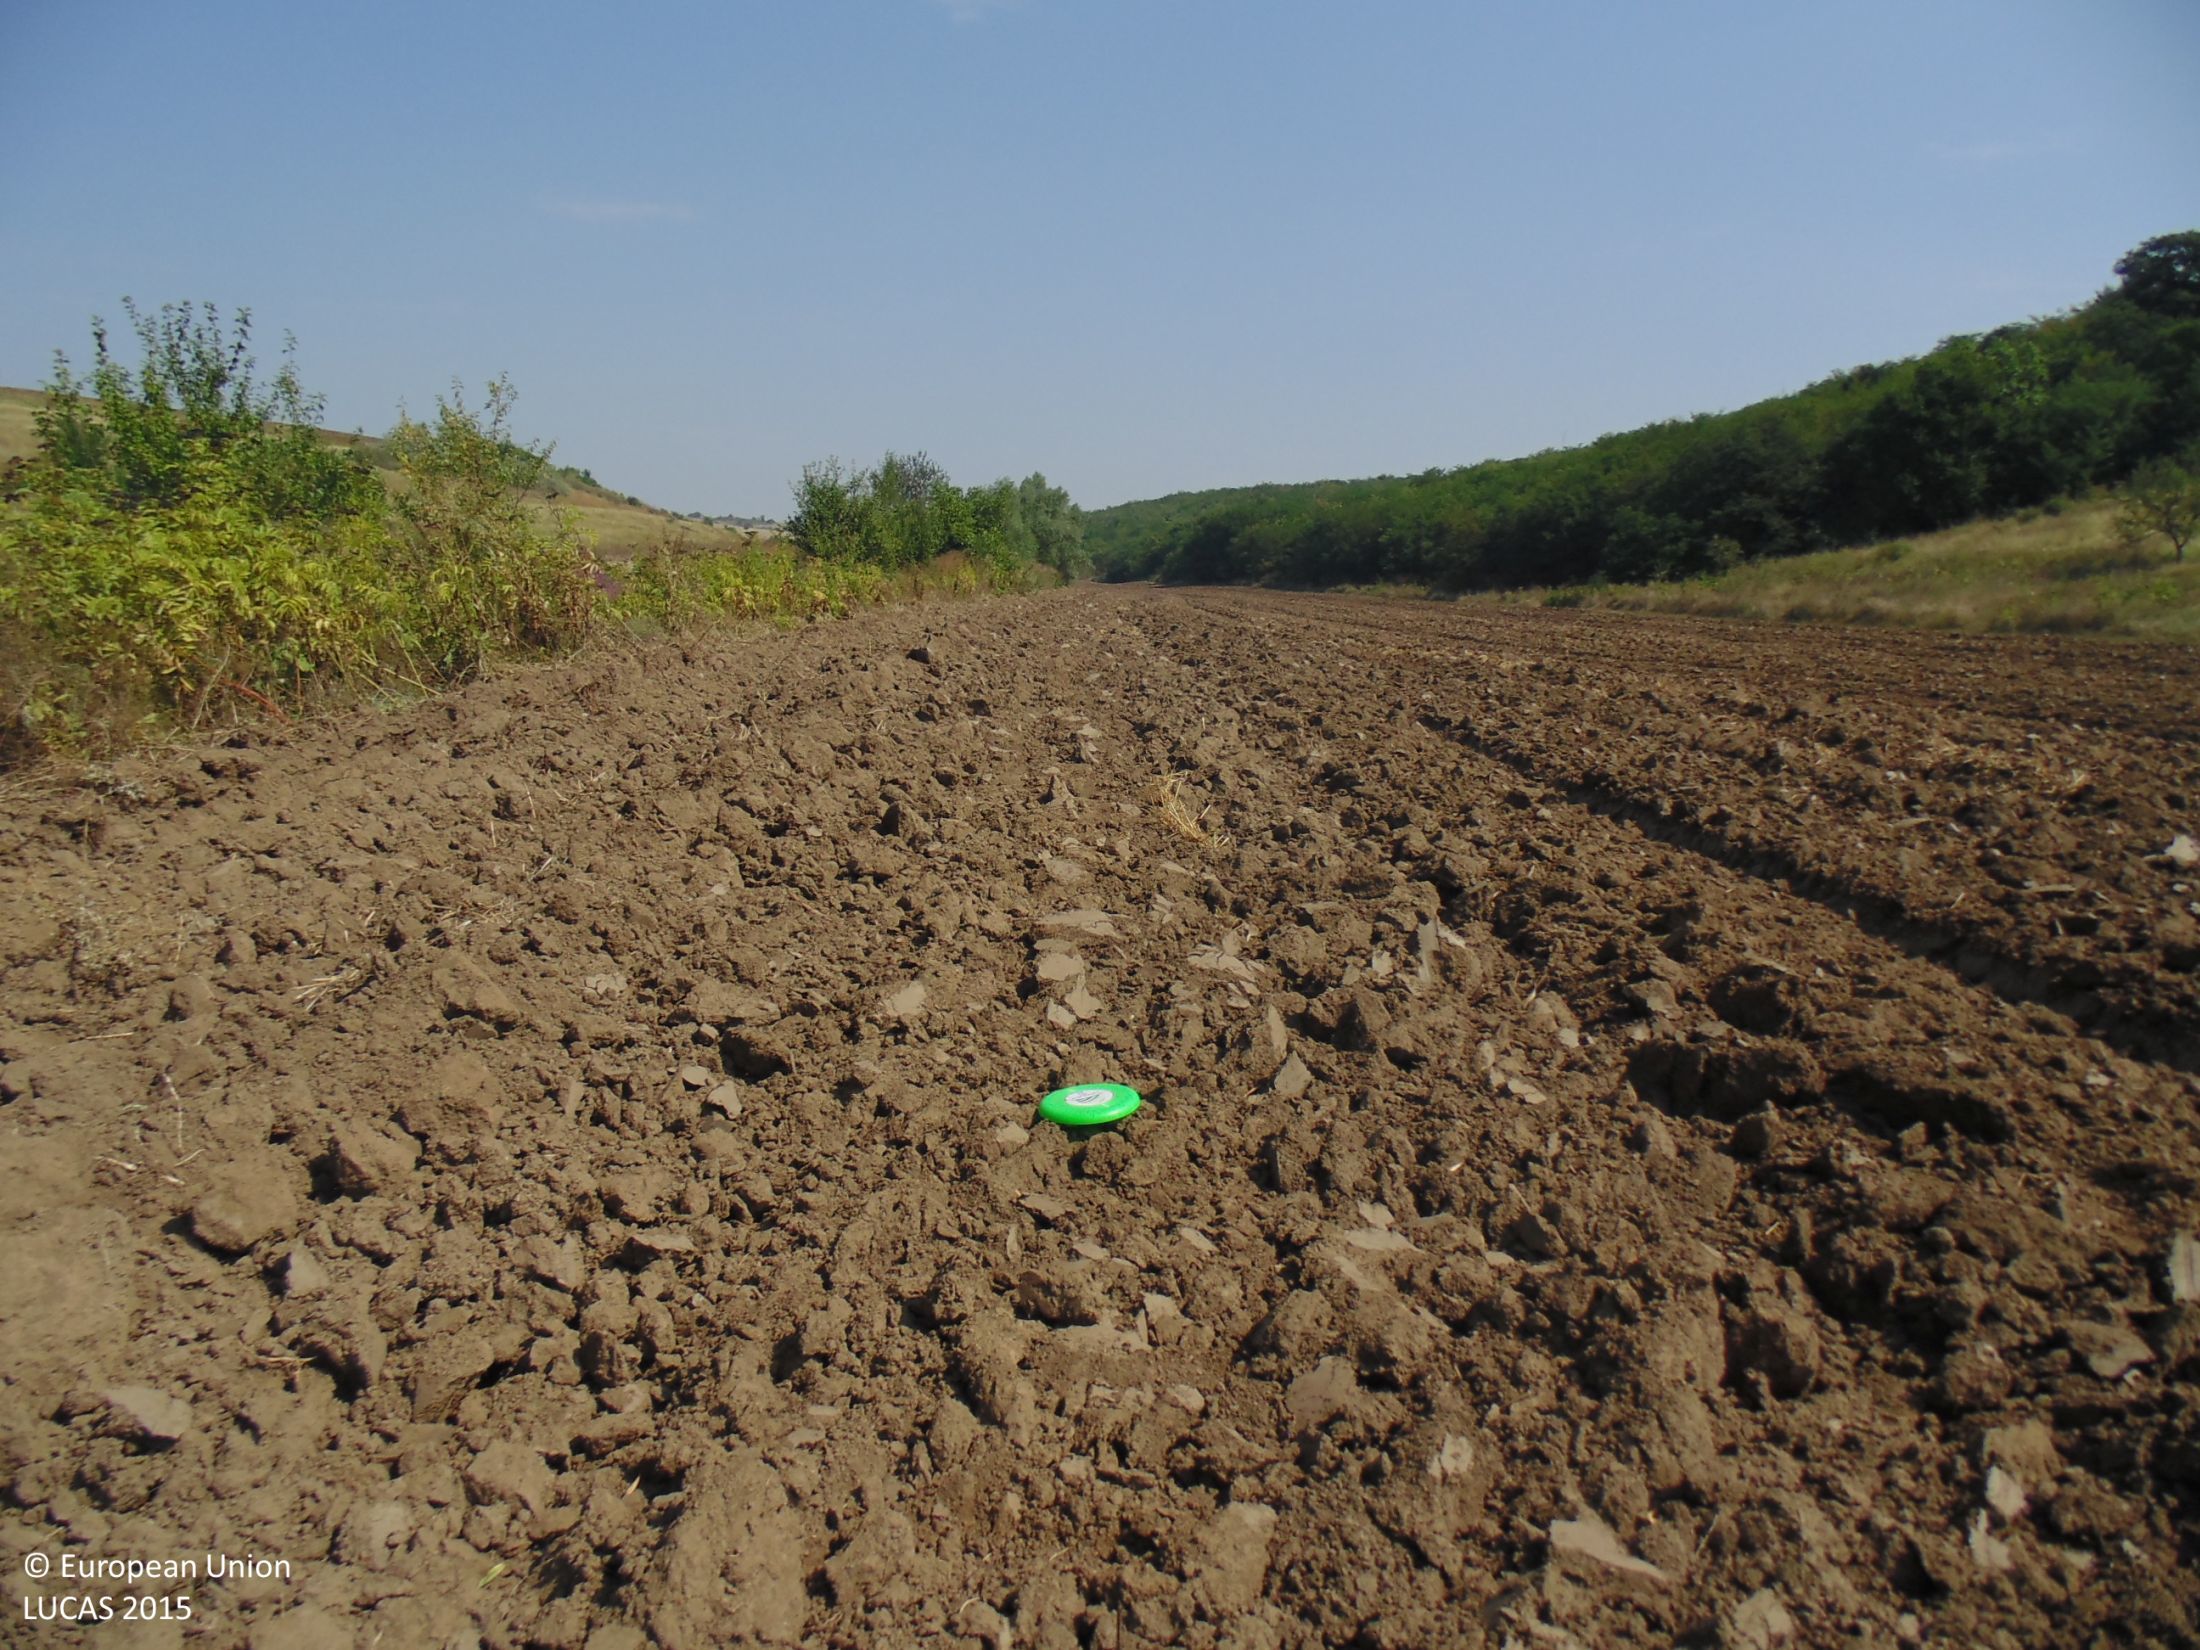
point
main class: Cropland
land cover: Common wheat
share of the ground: < 10 %
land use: Agriculture (excluding fallow land and kitchen gardens)
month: August
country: BG
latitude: 44.0412
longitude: 27.3167
